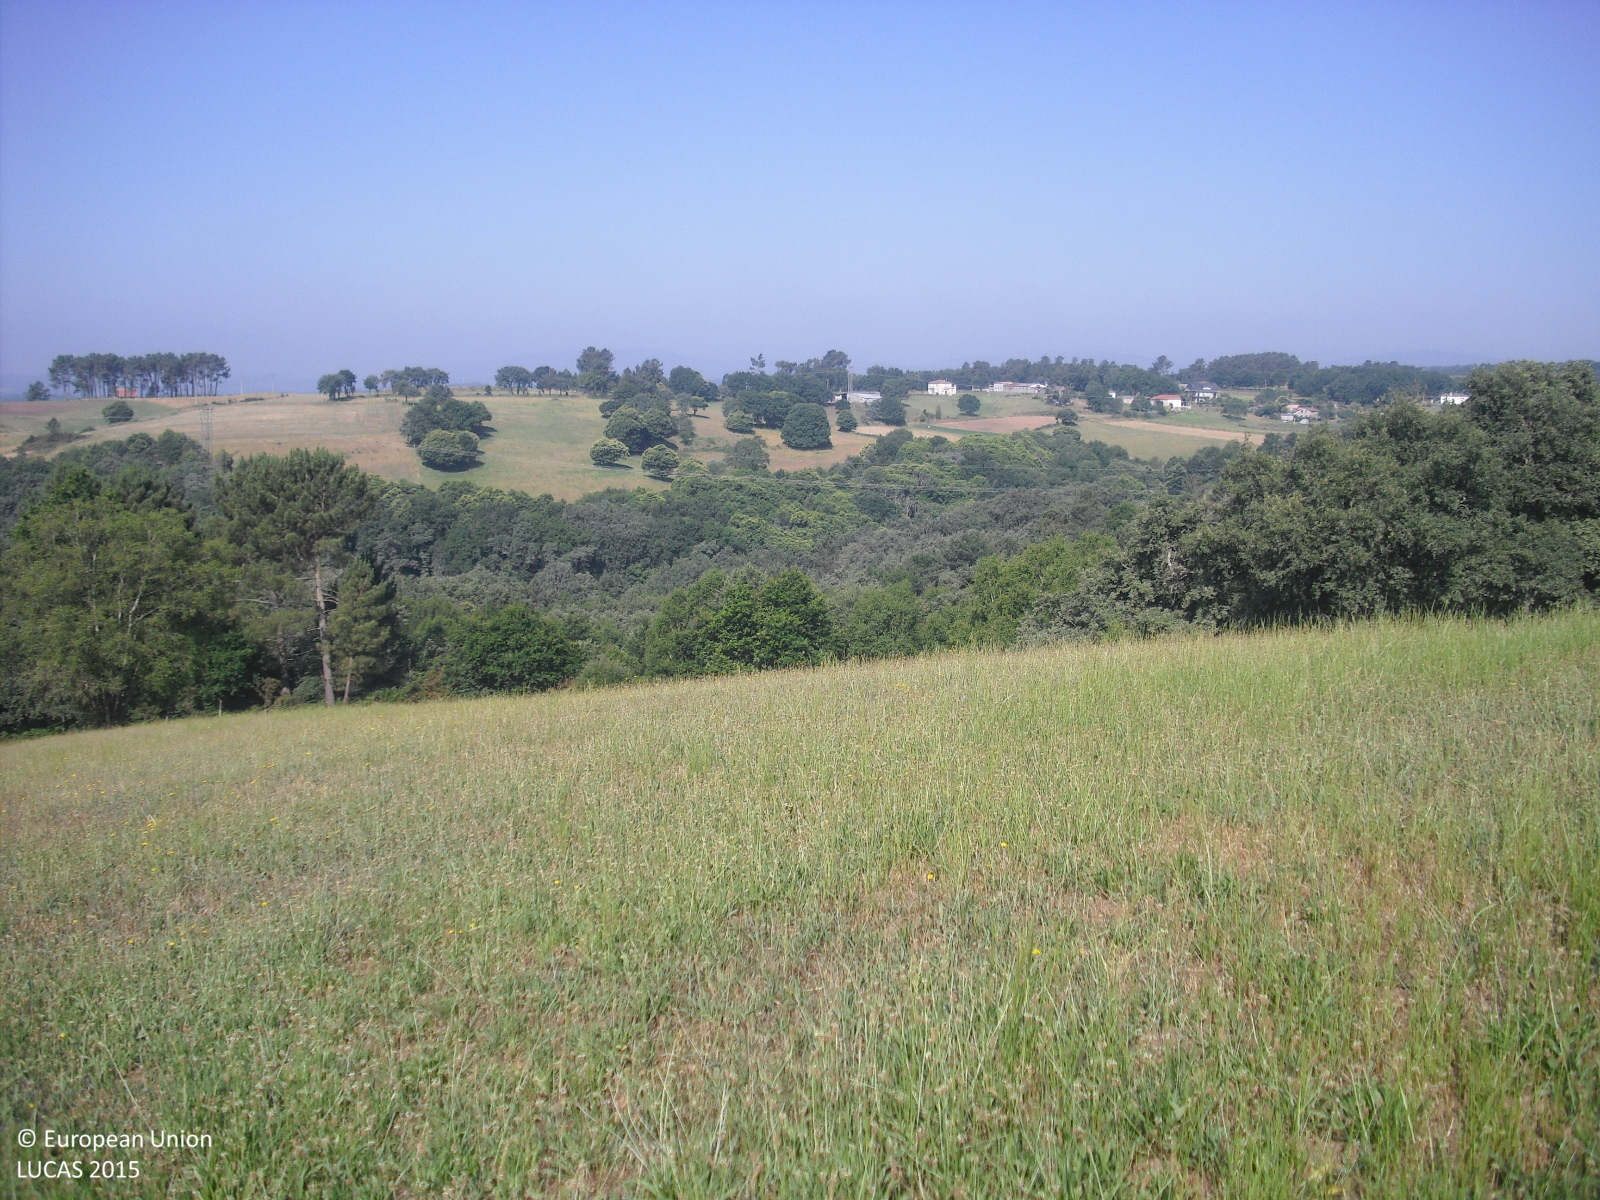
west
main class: Cropland
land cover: Temporary grasslands
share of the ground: > 75 %
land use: Agriculture (excluding fallow land and kitchen gardens)
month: June
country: ES
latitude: 42.5476
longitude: -7.7465
